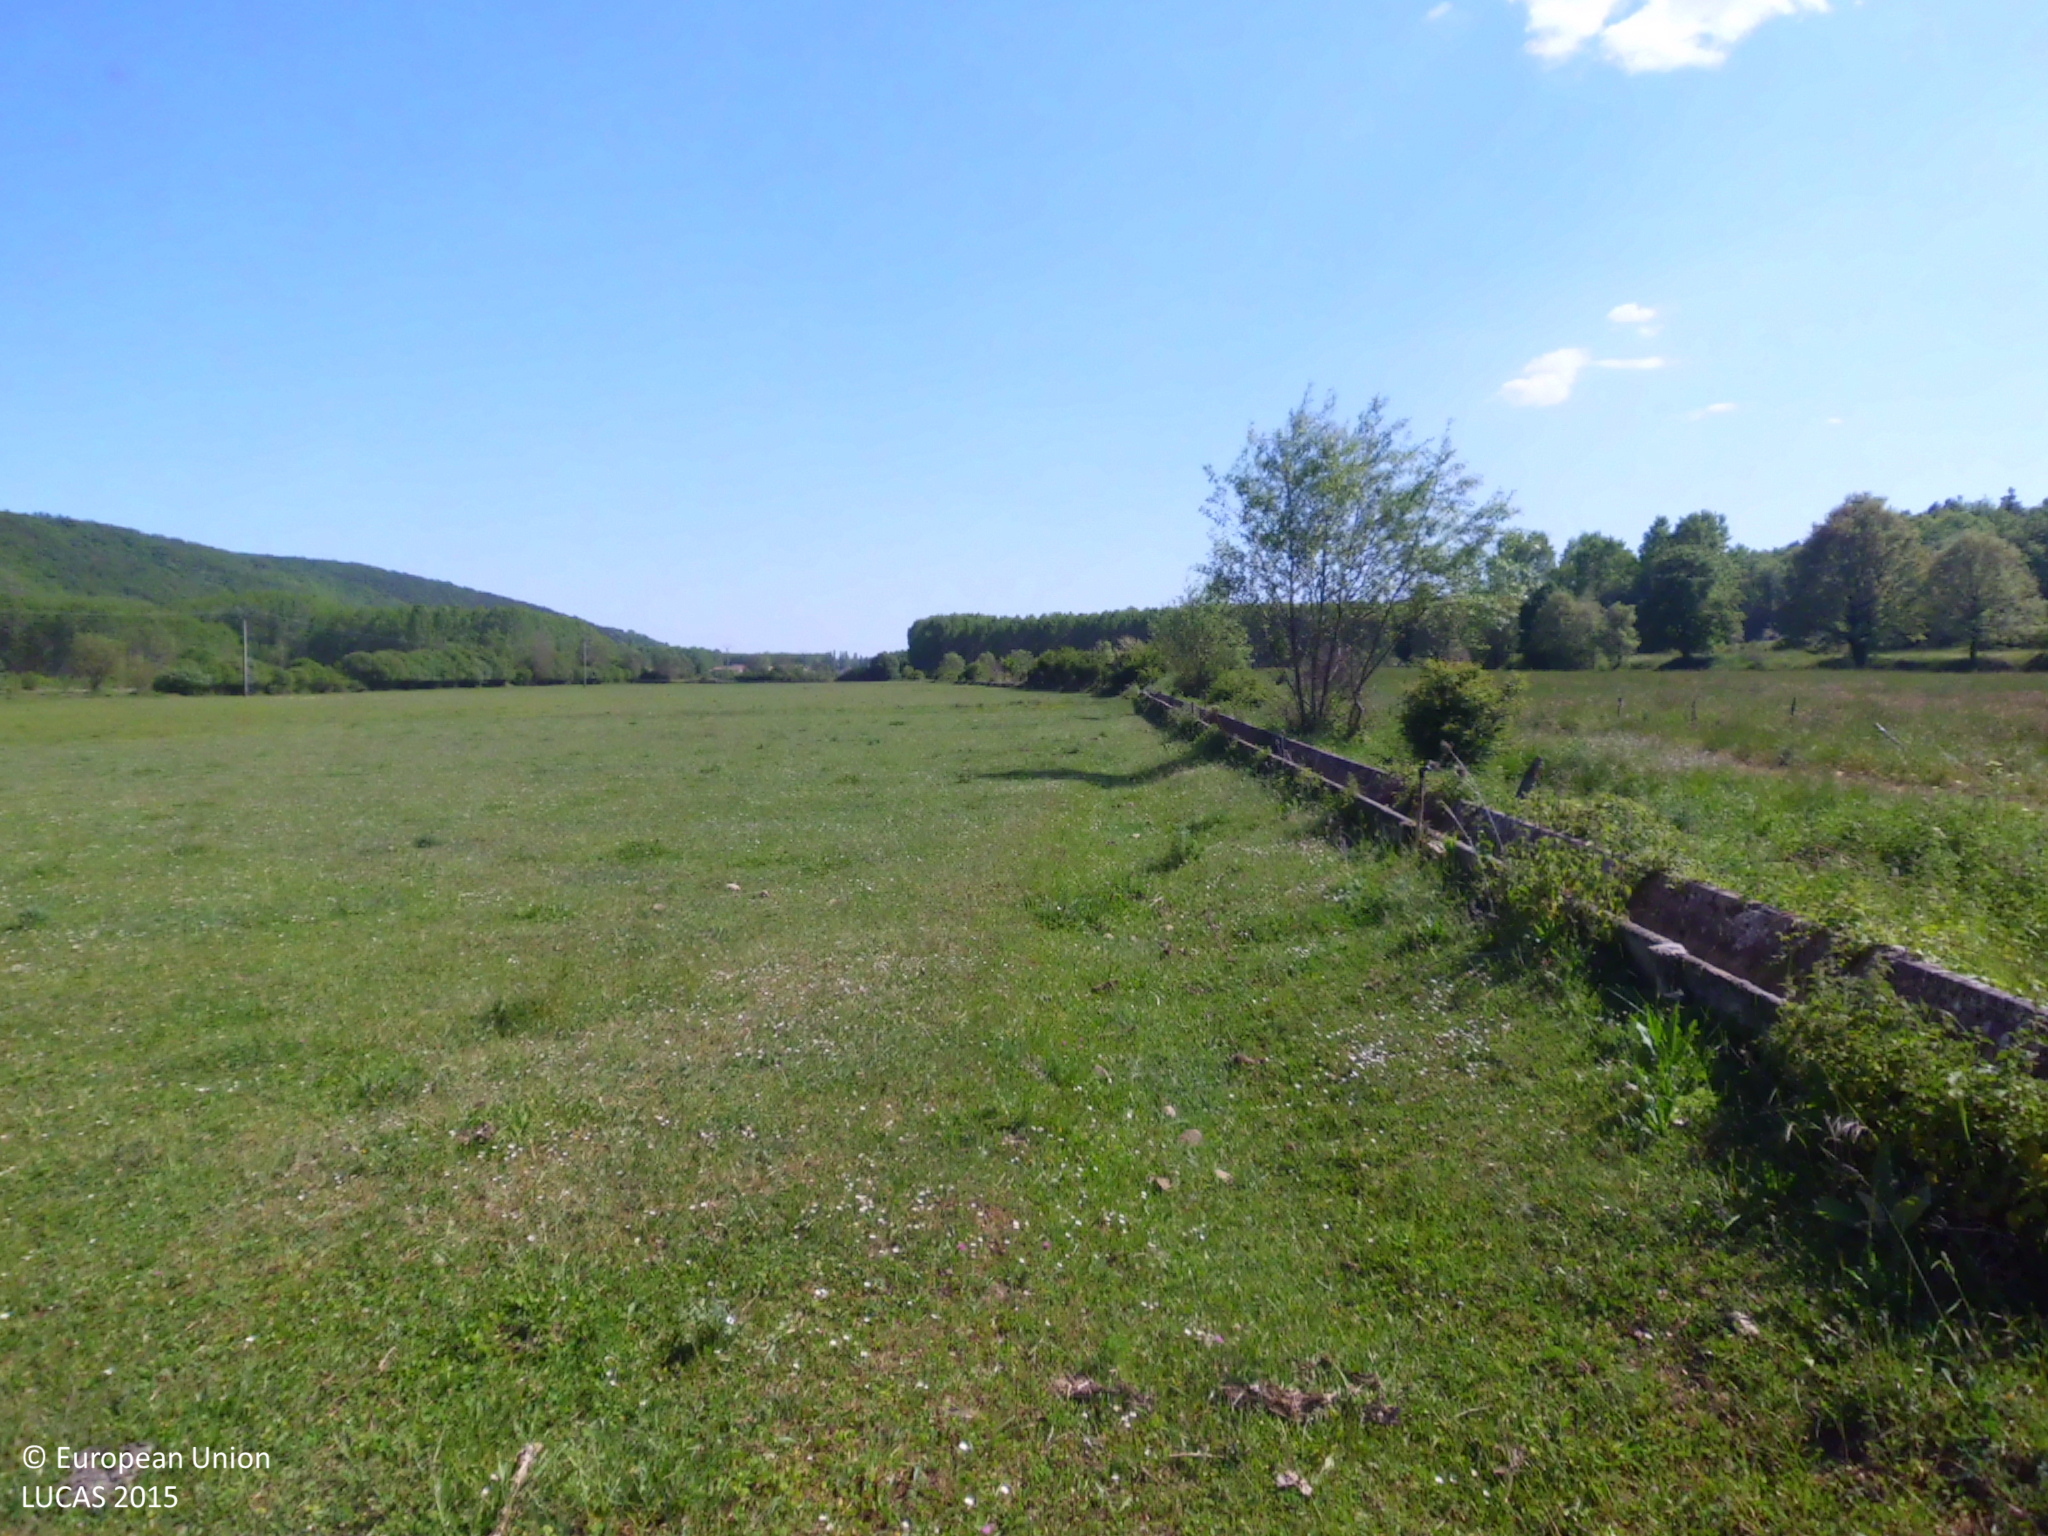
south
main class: Grassland
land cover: Grassland without tree/shrub cover
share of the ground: > 75 %
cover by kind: herbaceous plants 85 %, consolidated bare surface 10 %, shrubs 5 %
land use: Agriculture (excluding fallow land and kitchen gardens)
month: May
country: ES
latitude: 42.7871
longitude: -5.4136
